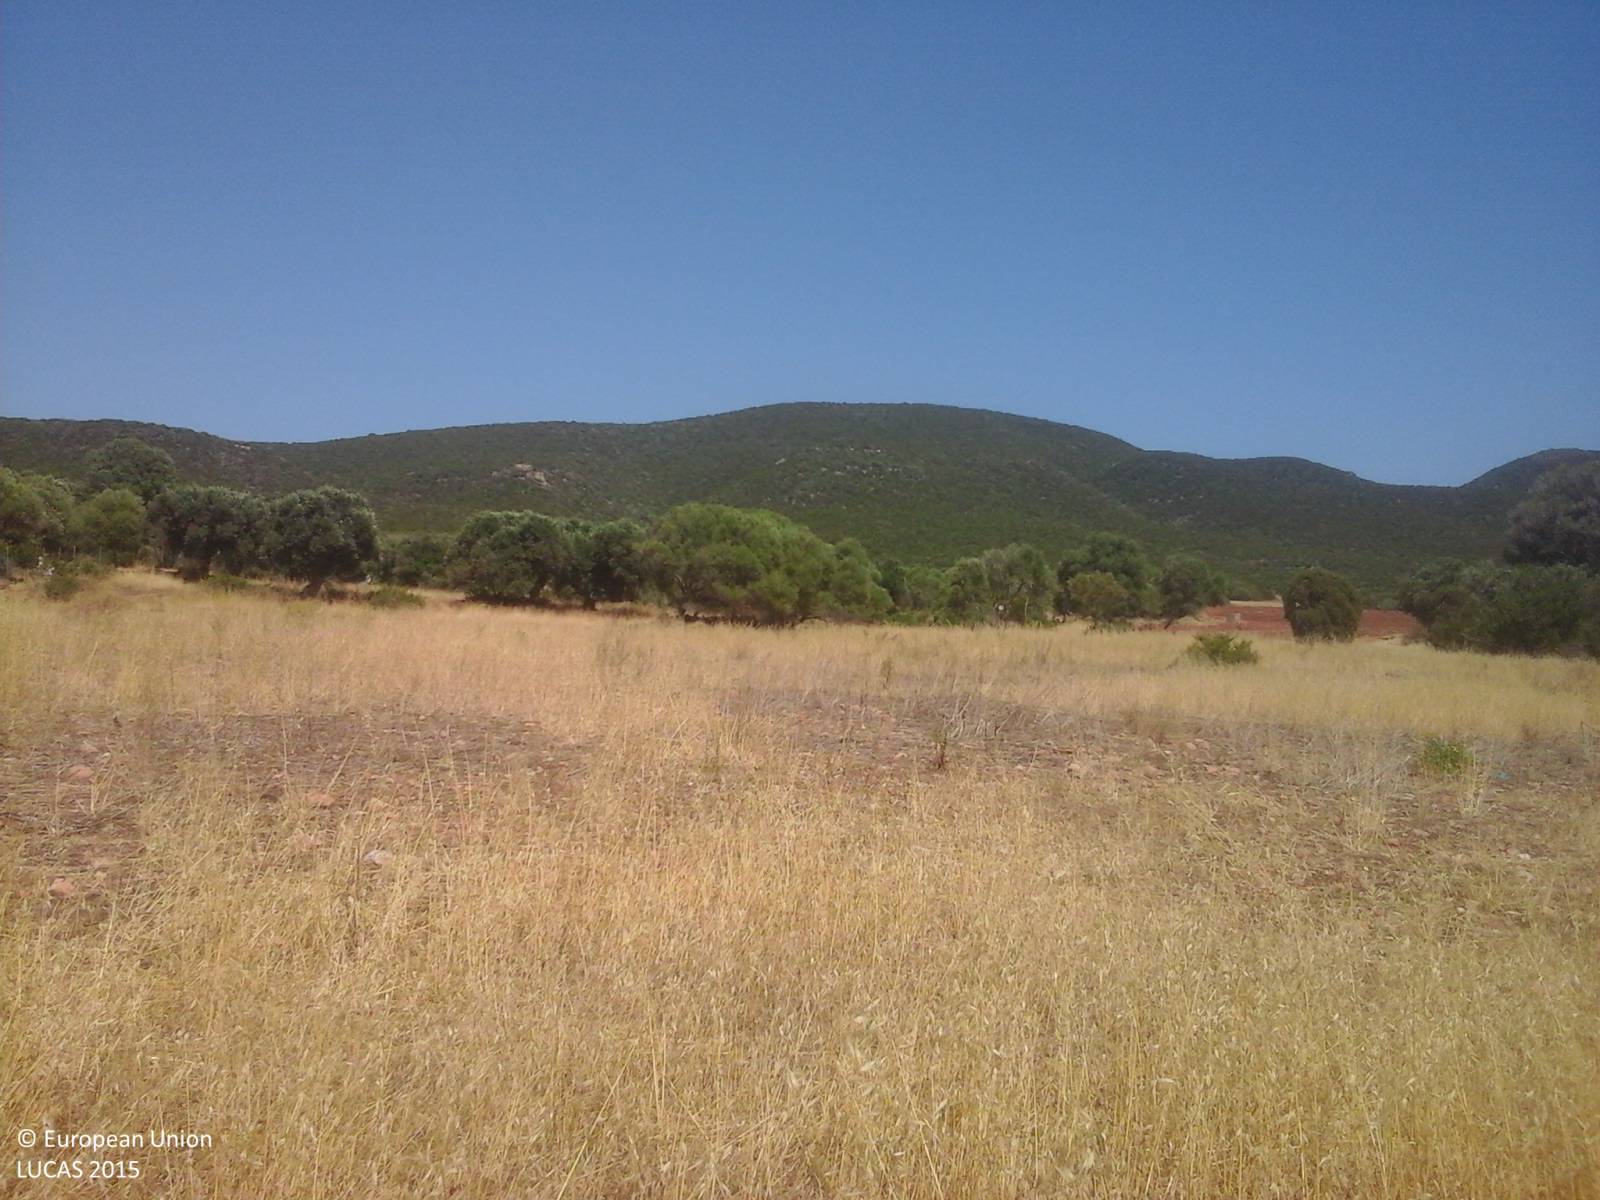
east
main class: Cropland
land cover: Oats
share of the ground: > 75 %
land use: Agriculture (excluding fallow land and kitchen gardens)
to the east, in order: Oats; Single bushes/trees; Tracks; Shrubland with sparse tree cover; Broadleaved woodland
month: June
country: IT
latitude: 39.0440
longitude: 8.6338
